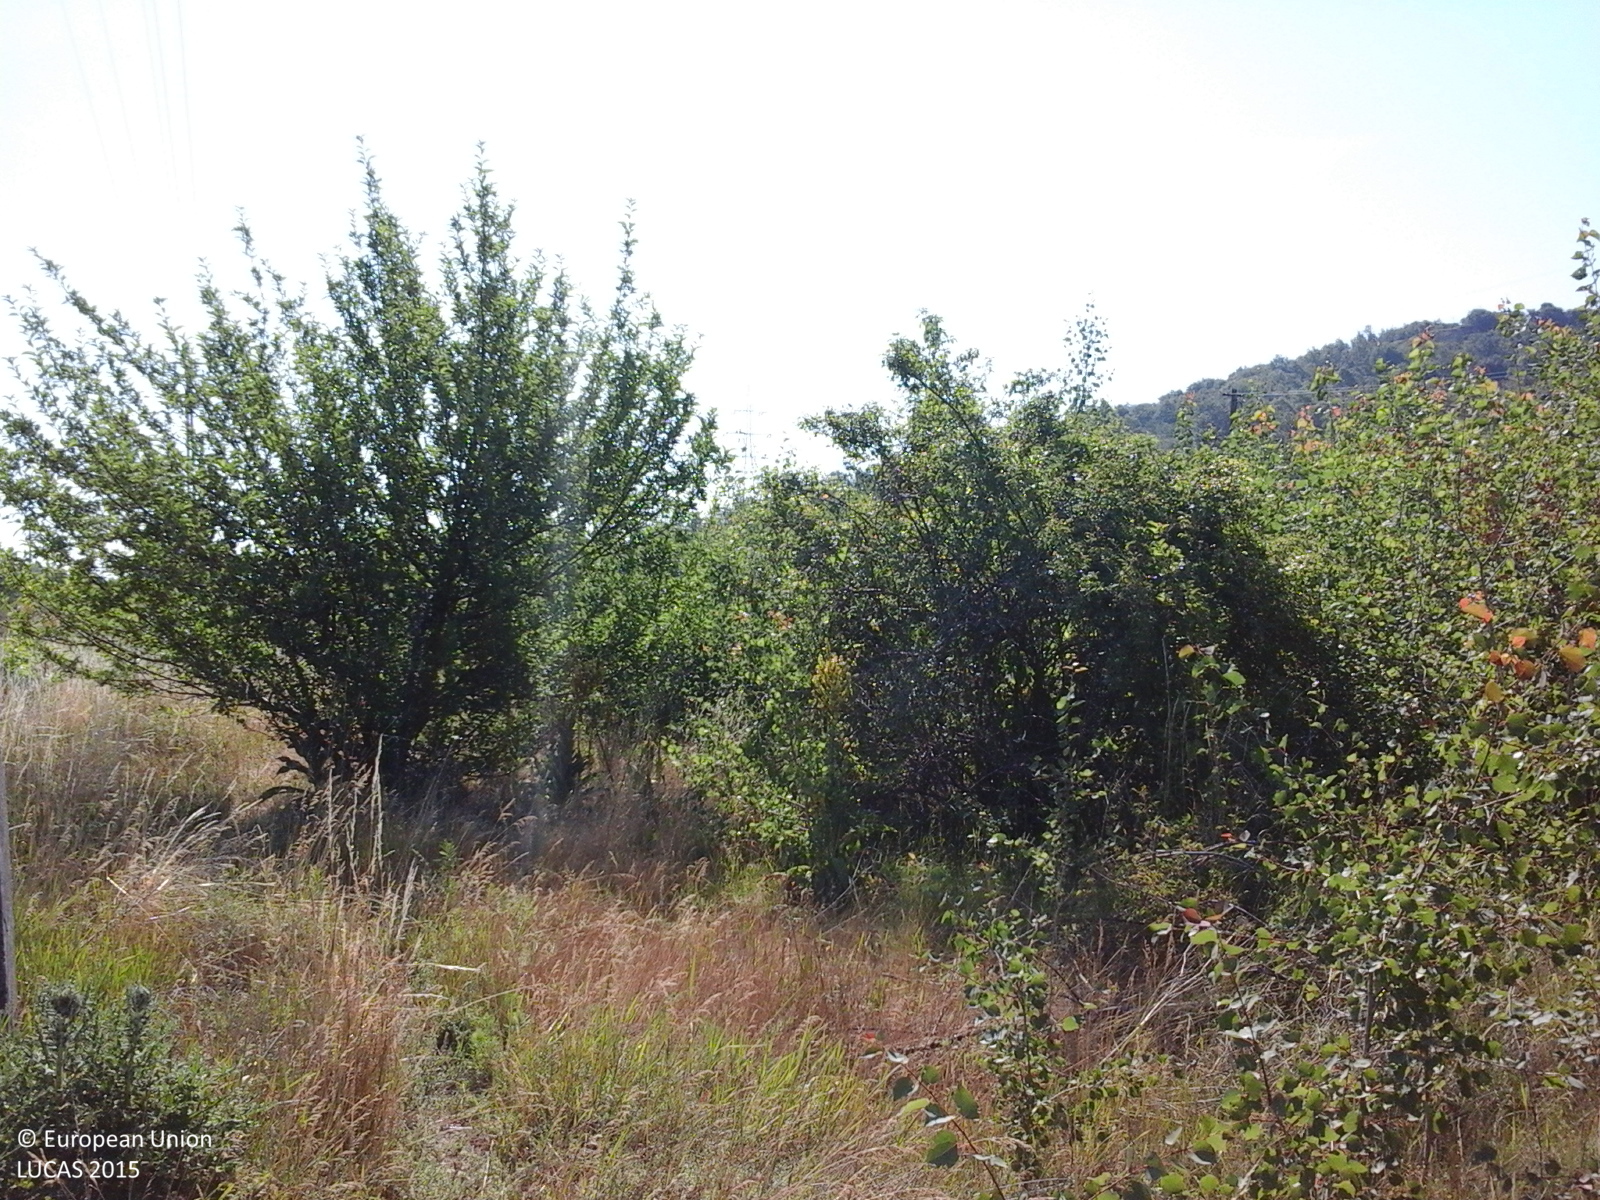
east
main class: Grassland
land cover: Grassland with sparse tree/shrub cover
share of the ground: 25 - 50 %
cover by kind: herbaceous plants 90 %, broadleaved forest trees 5 %, shrubs 5 %
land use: Railway transport
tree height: < 5 m
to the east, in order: Grassland with sparse tree/shrub cover; Fences; Grassland with sparse tree/shrub cover; Spontaneously vegetated surfaces
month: June
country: RO
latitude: 47.1396
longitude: 27.6164
